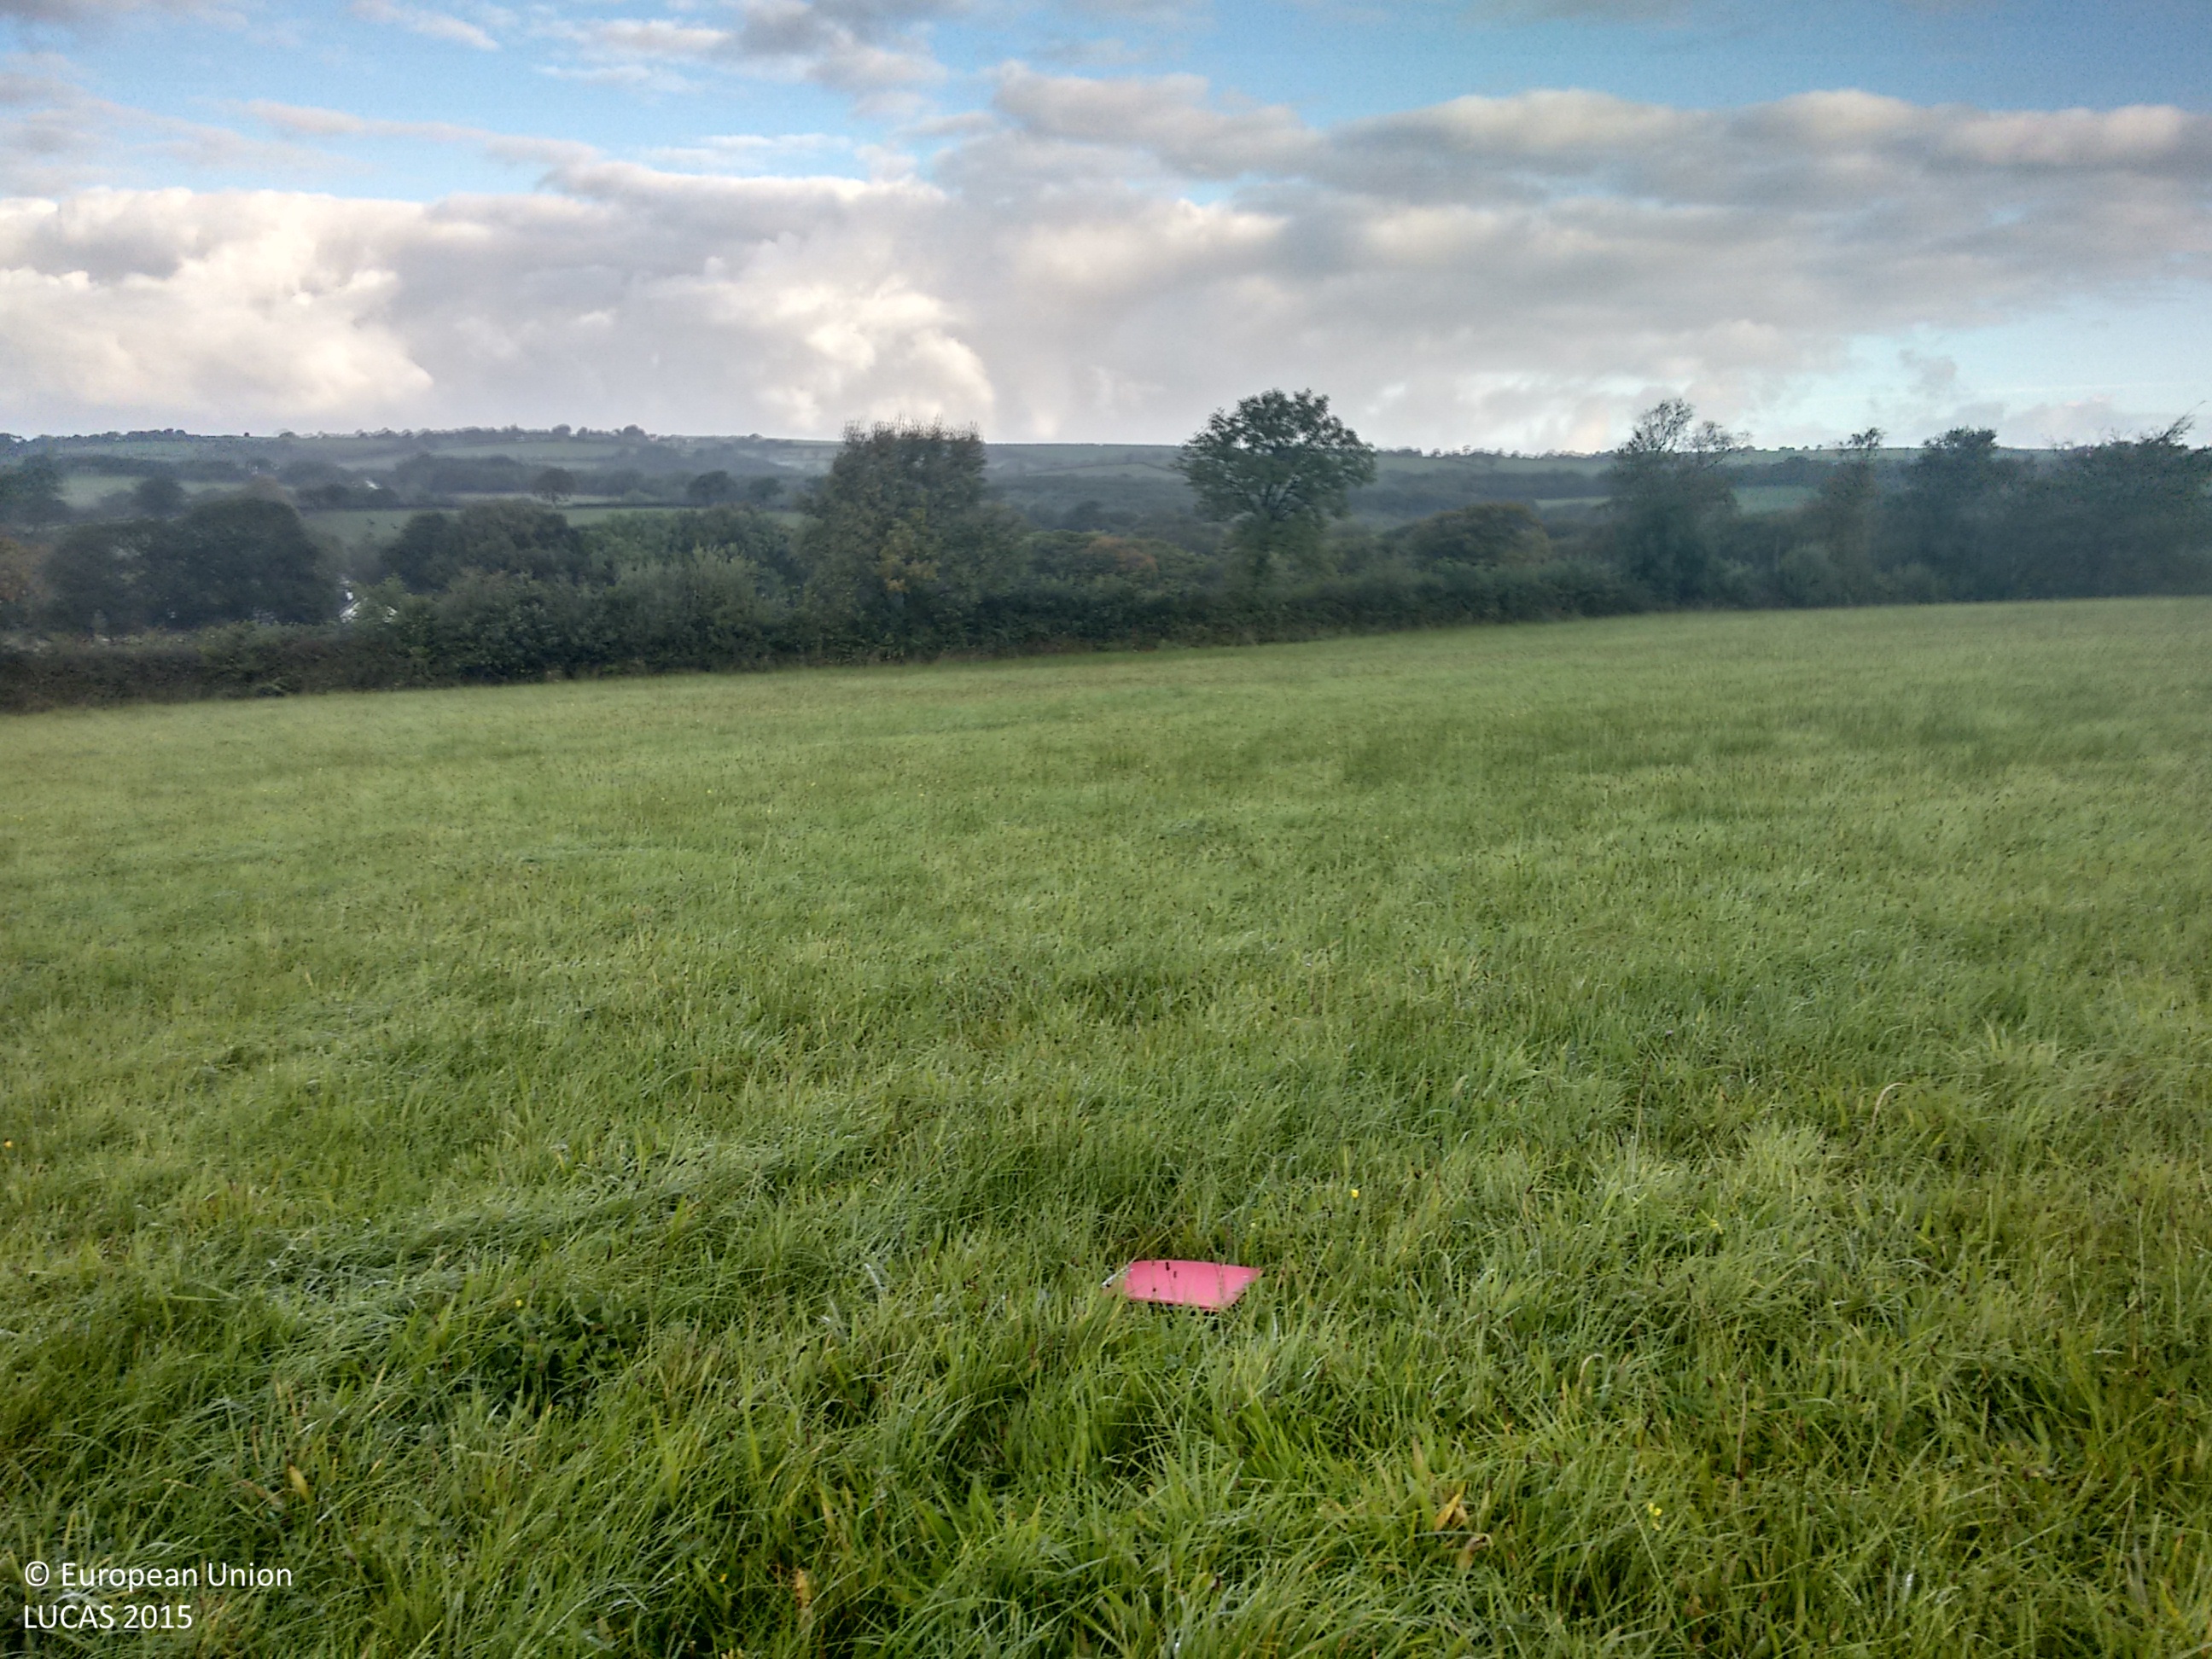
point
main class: Grassland
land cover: Grassland without tree/shrub cover
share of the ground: > 75 %
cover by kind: herbaceous plants 100 %
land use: Agriculture (excluding fallow land and kitchen gardens)
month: September
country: GB
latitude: 50.7082
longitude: -4.1011
